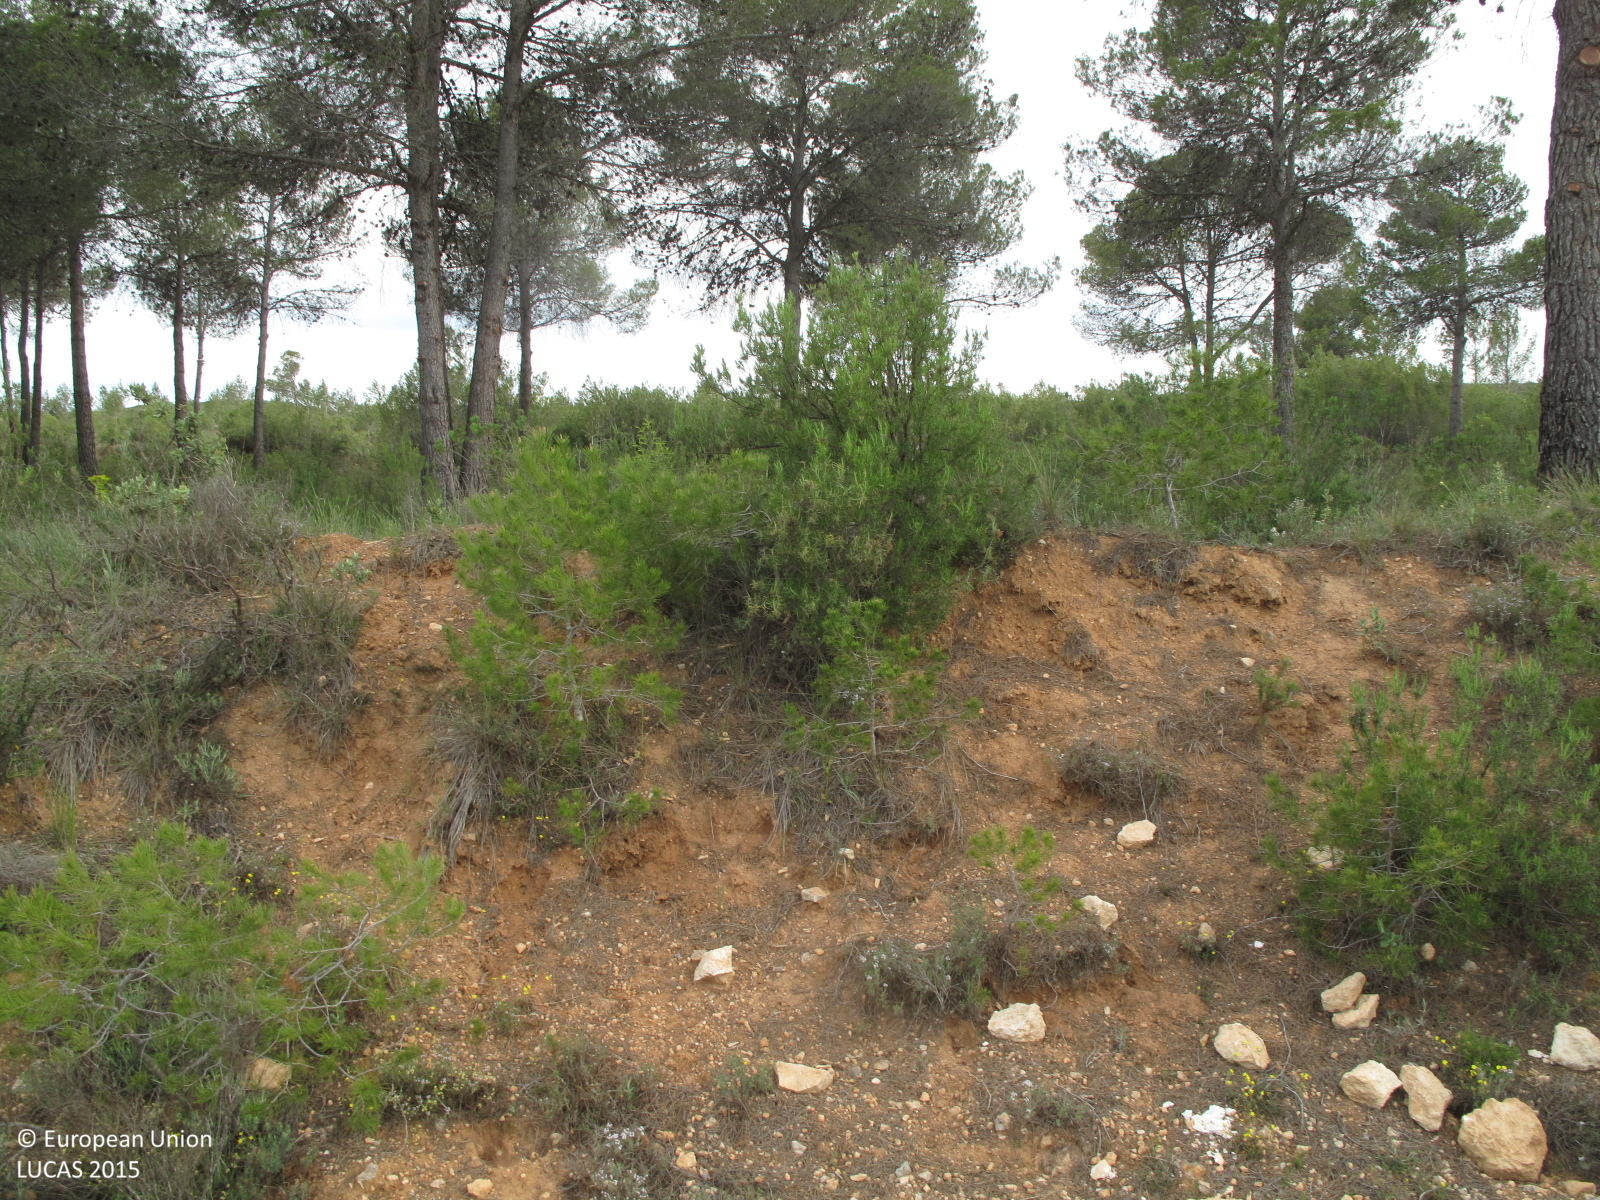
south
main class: Cropland
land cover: Common wheat
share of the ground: 50 - 75 %
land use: Agriculture (excluding fallow land and kitchen gardens)
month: May
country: ES
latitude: 38.7853
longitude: -0.7089
